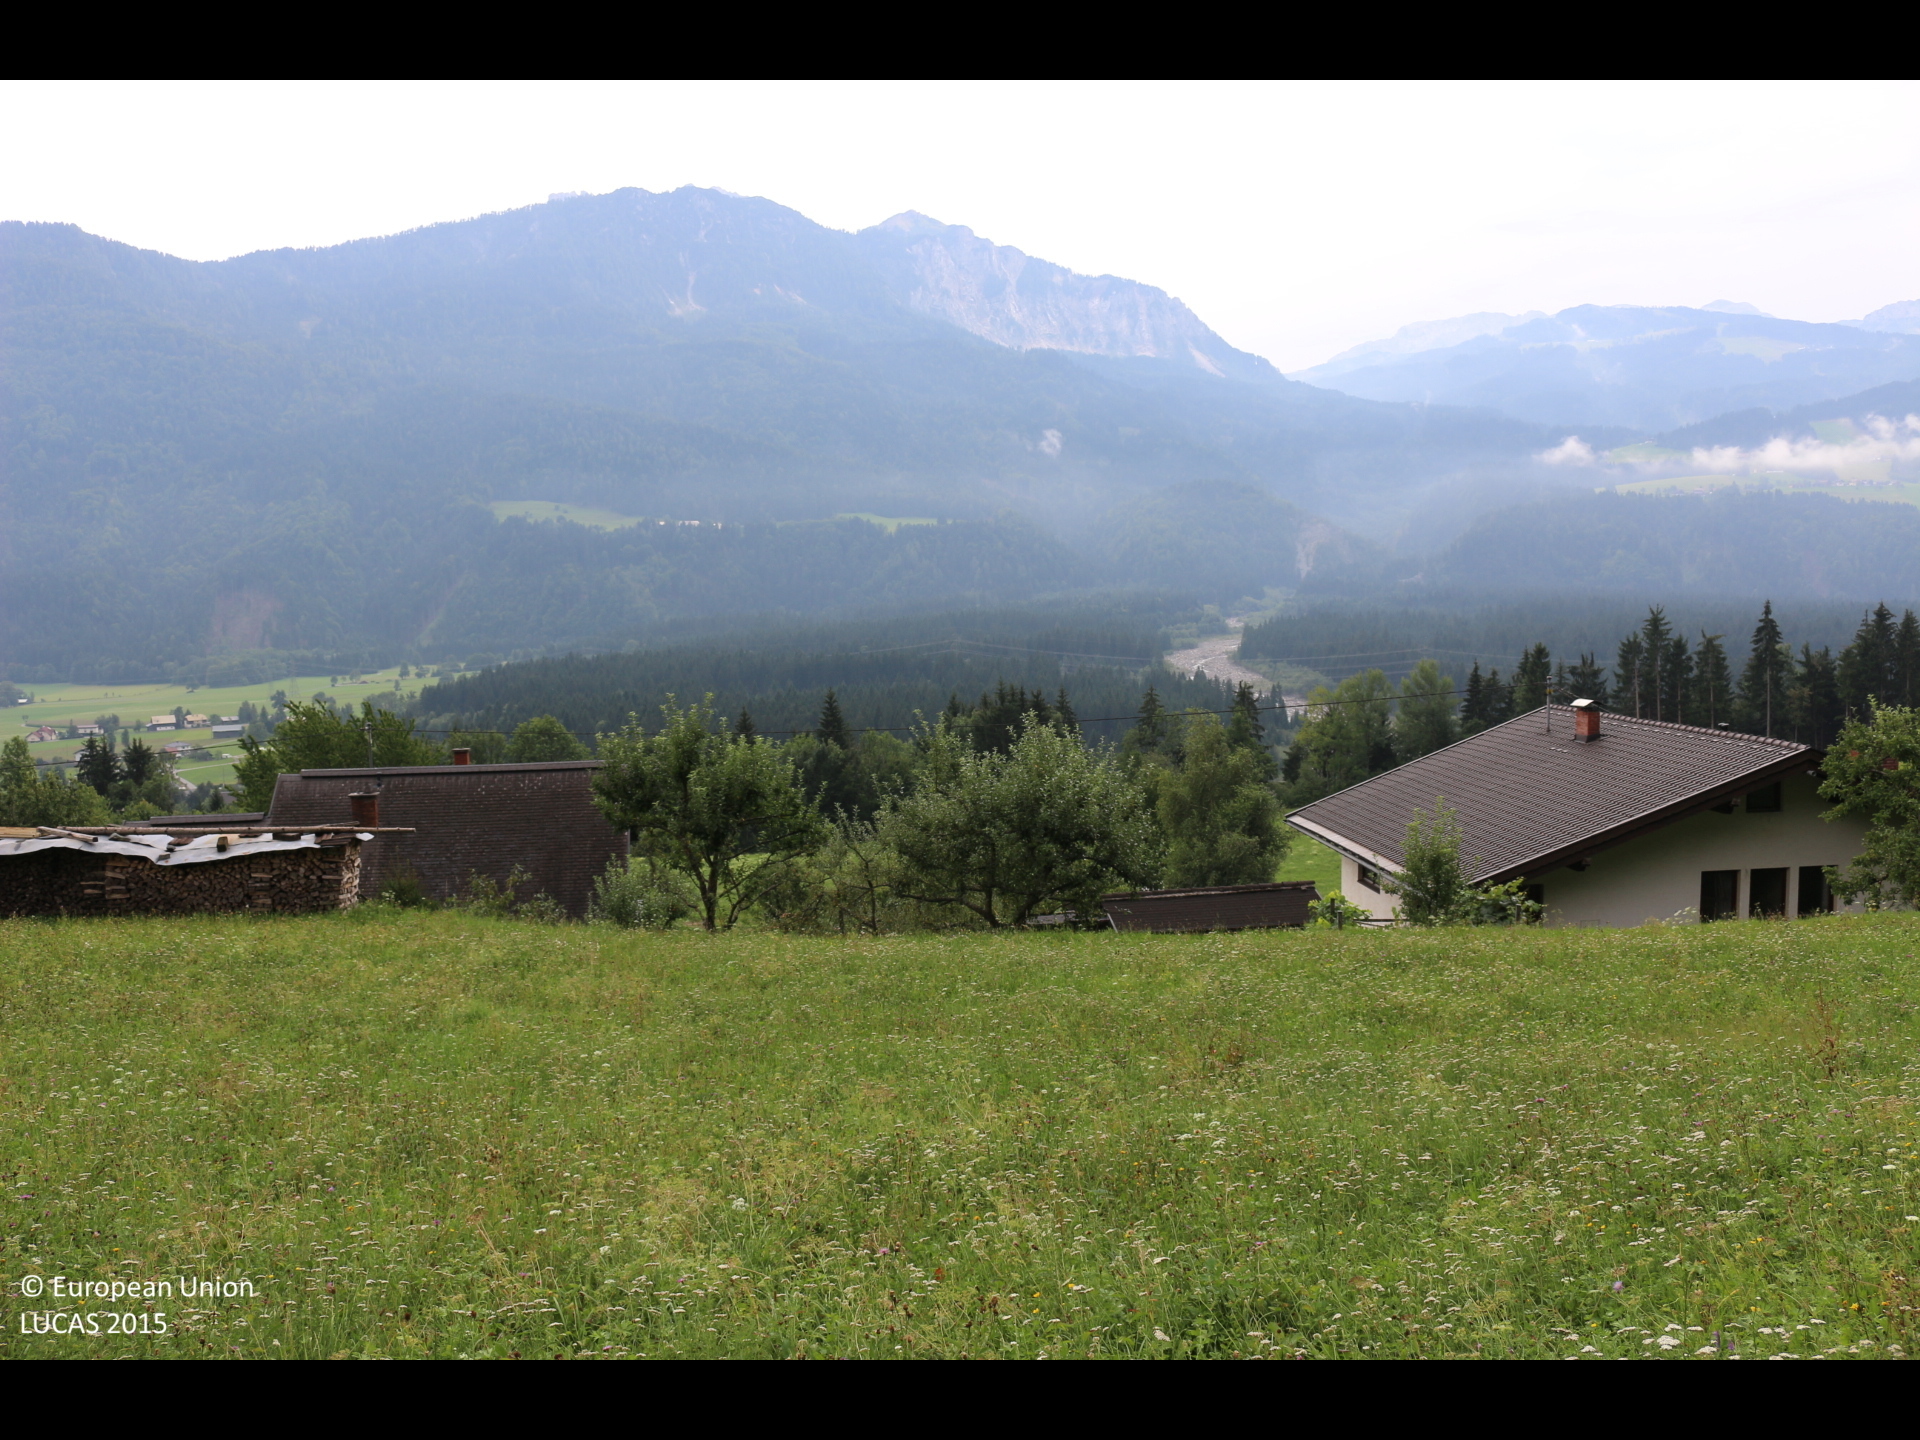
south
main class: Grassland
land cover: Grassland without tree/shrub cover
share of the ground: > 75 %
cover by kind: herbaceous plants 100 %
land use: Agriculture (excluding fallow land and kitchen gardens)
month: August
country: AT
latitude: 46.6247
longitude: 13.3014
